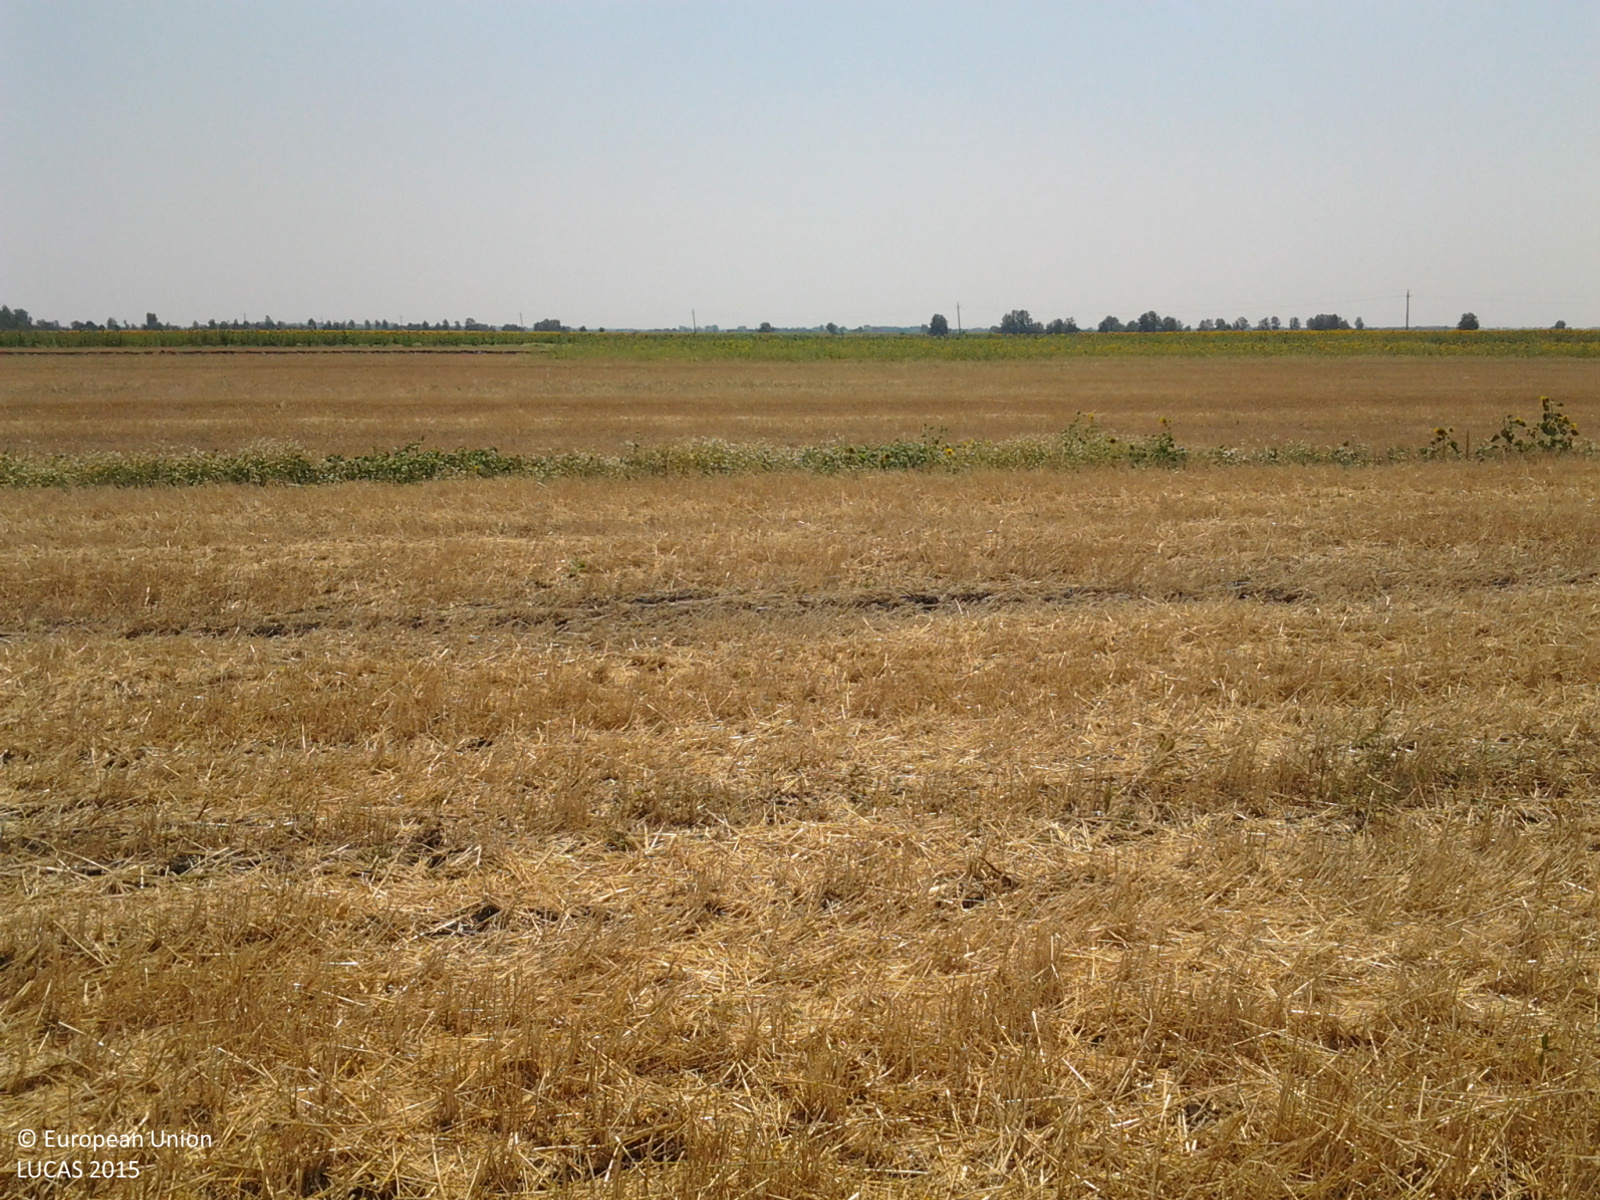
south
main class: Cropland
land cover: Common wheat
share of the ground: 10 - 25 %
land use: Agriculture (excluding fallow land and kitchen gardens)
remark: Harvested field
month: July
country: HU
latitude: 47.3676
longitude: 20.3979
